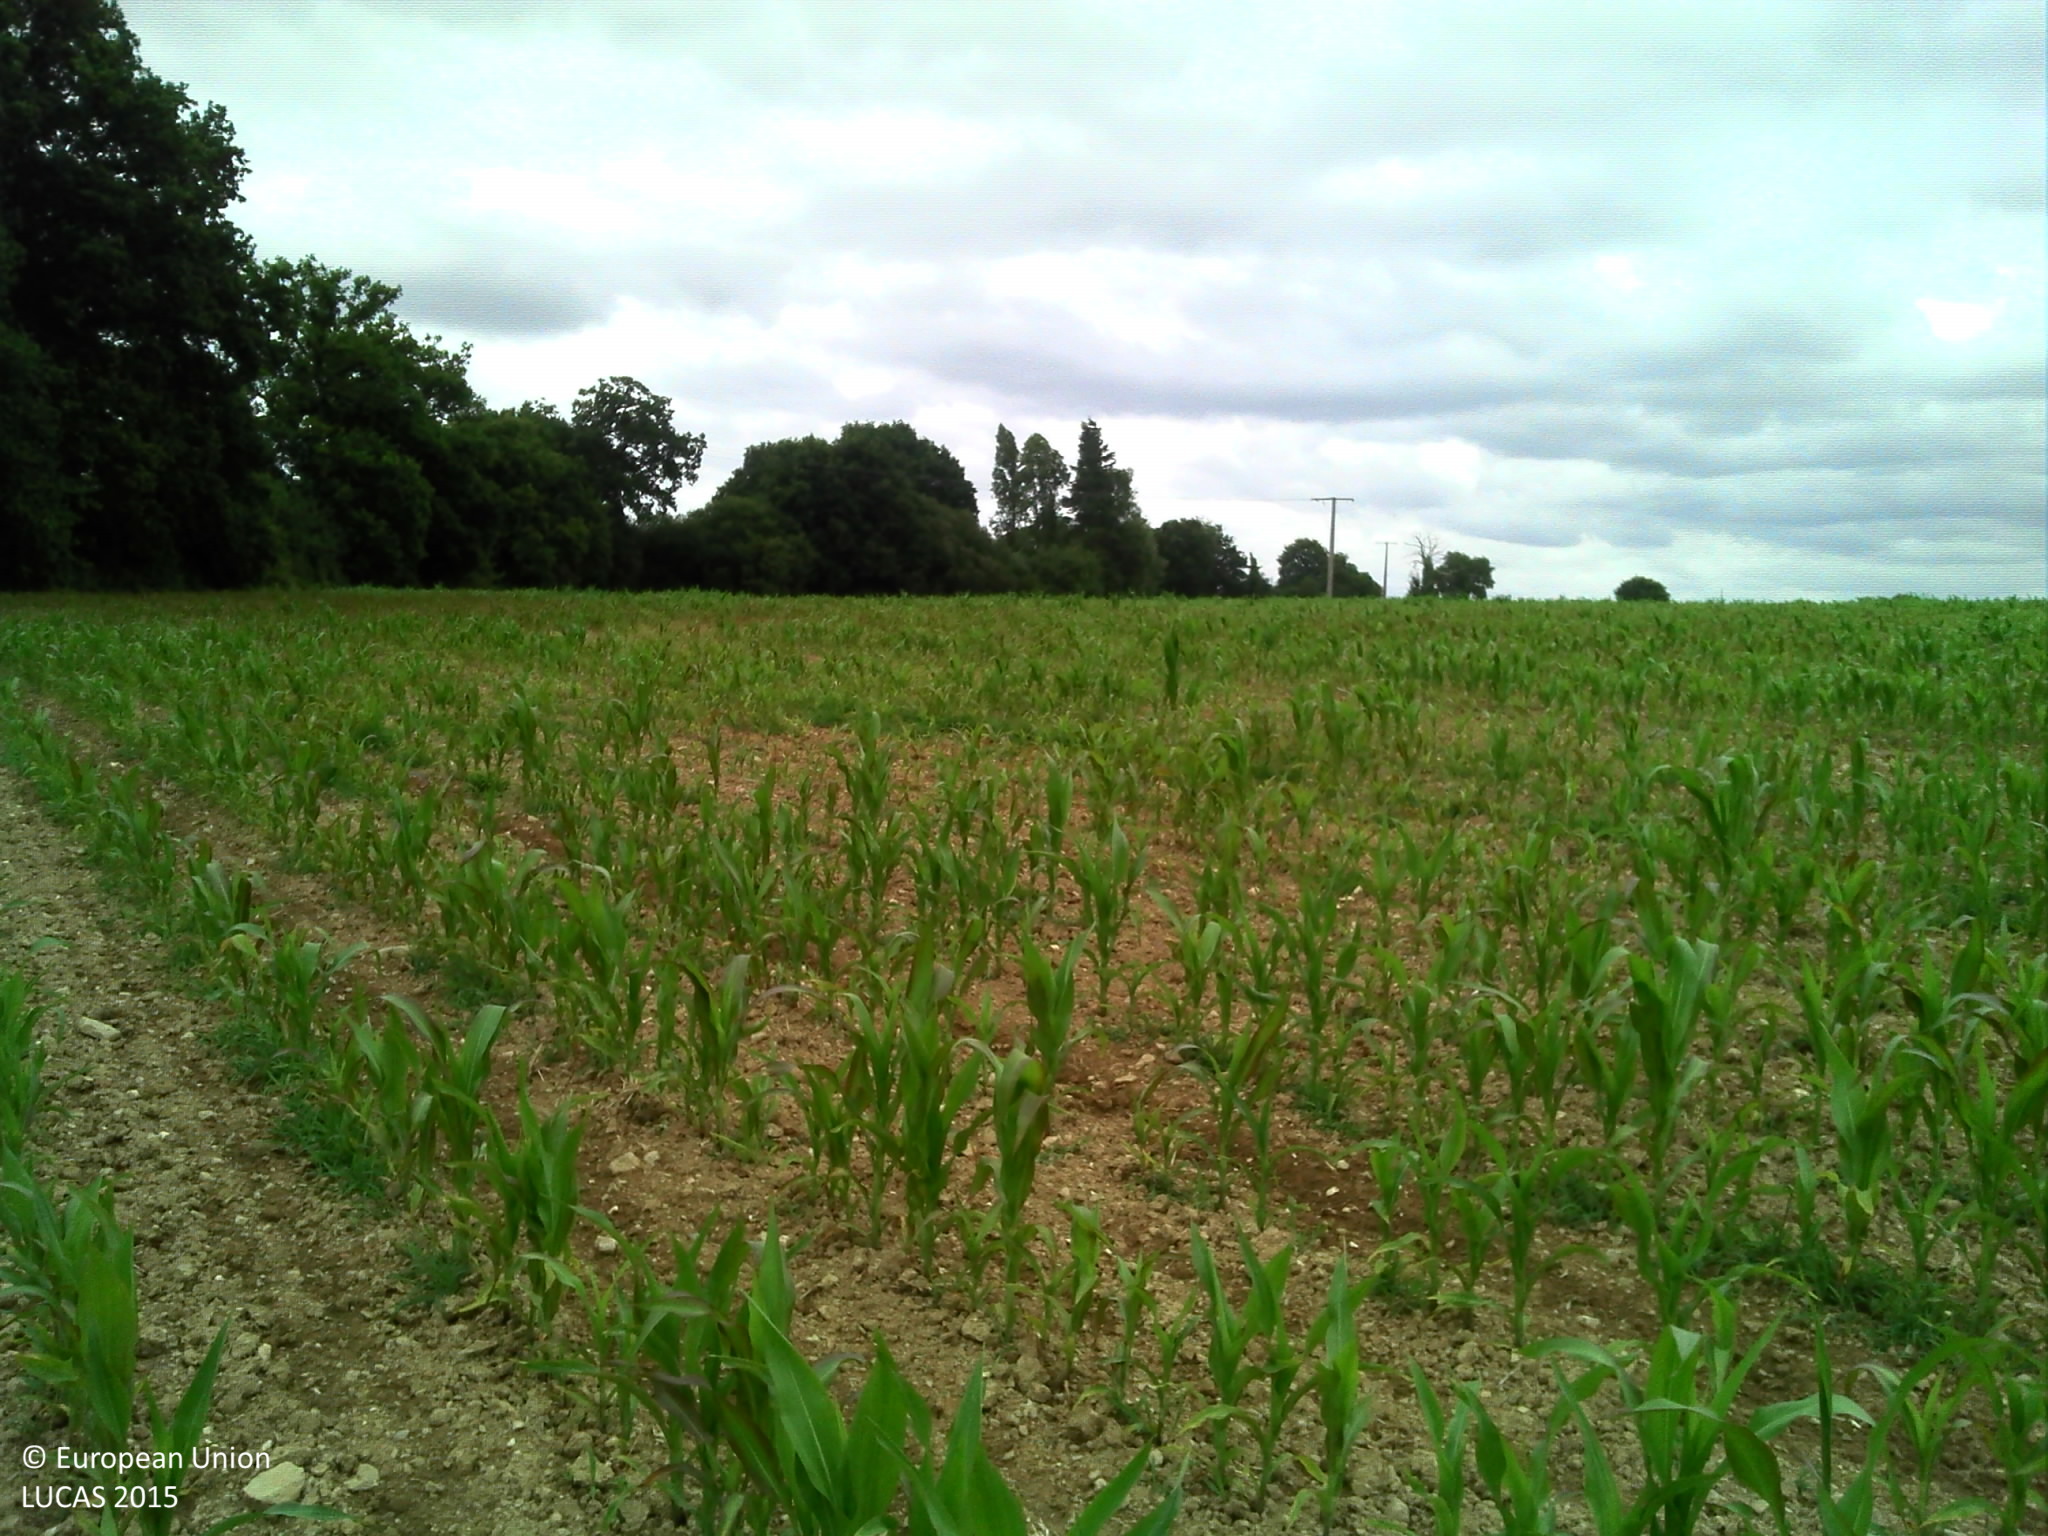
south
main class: Cropland
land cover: Maize
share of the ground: 10 - 25 %
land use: Agriculture (excluding fallow land and kitchen gardens)
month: July
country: FR
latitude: 47.8372
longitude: -2.0092
